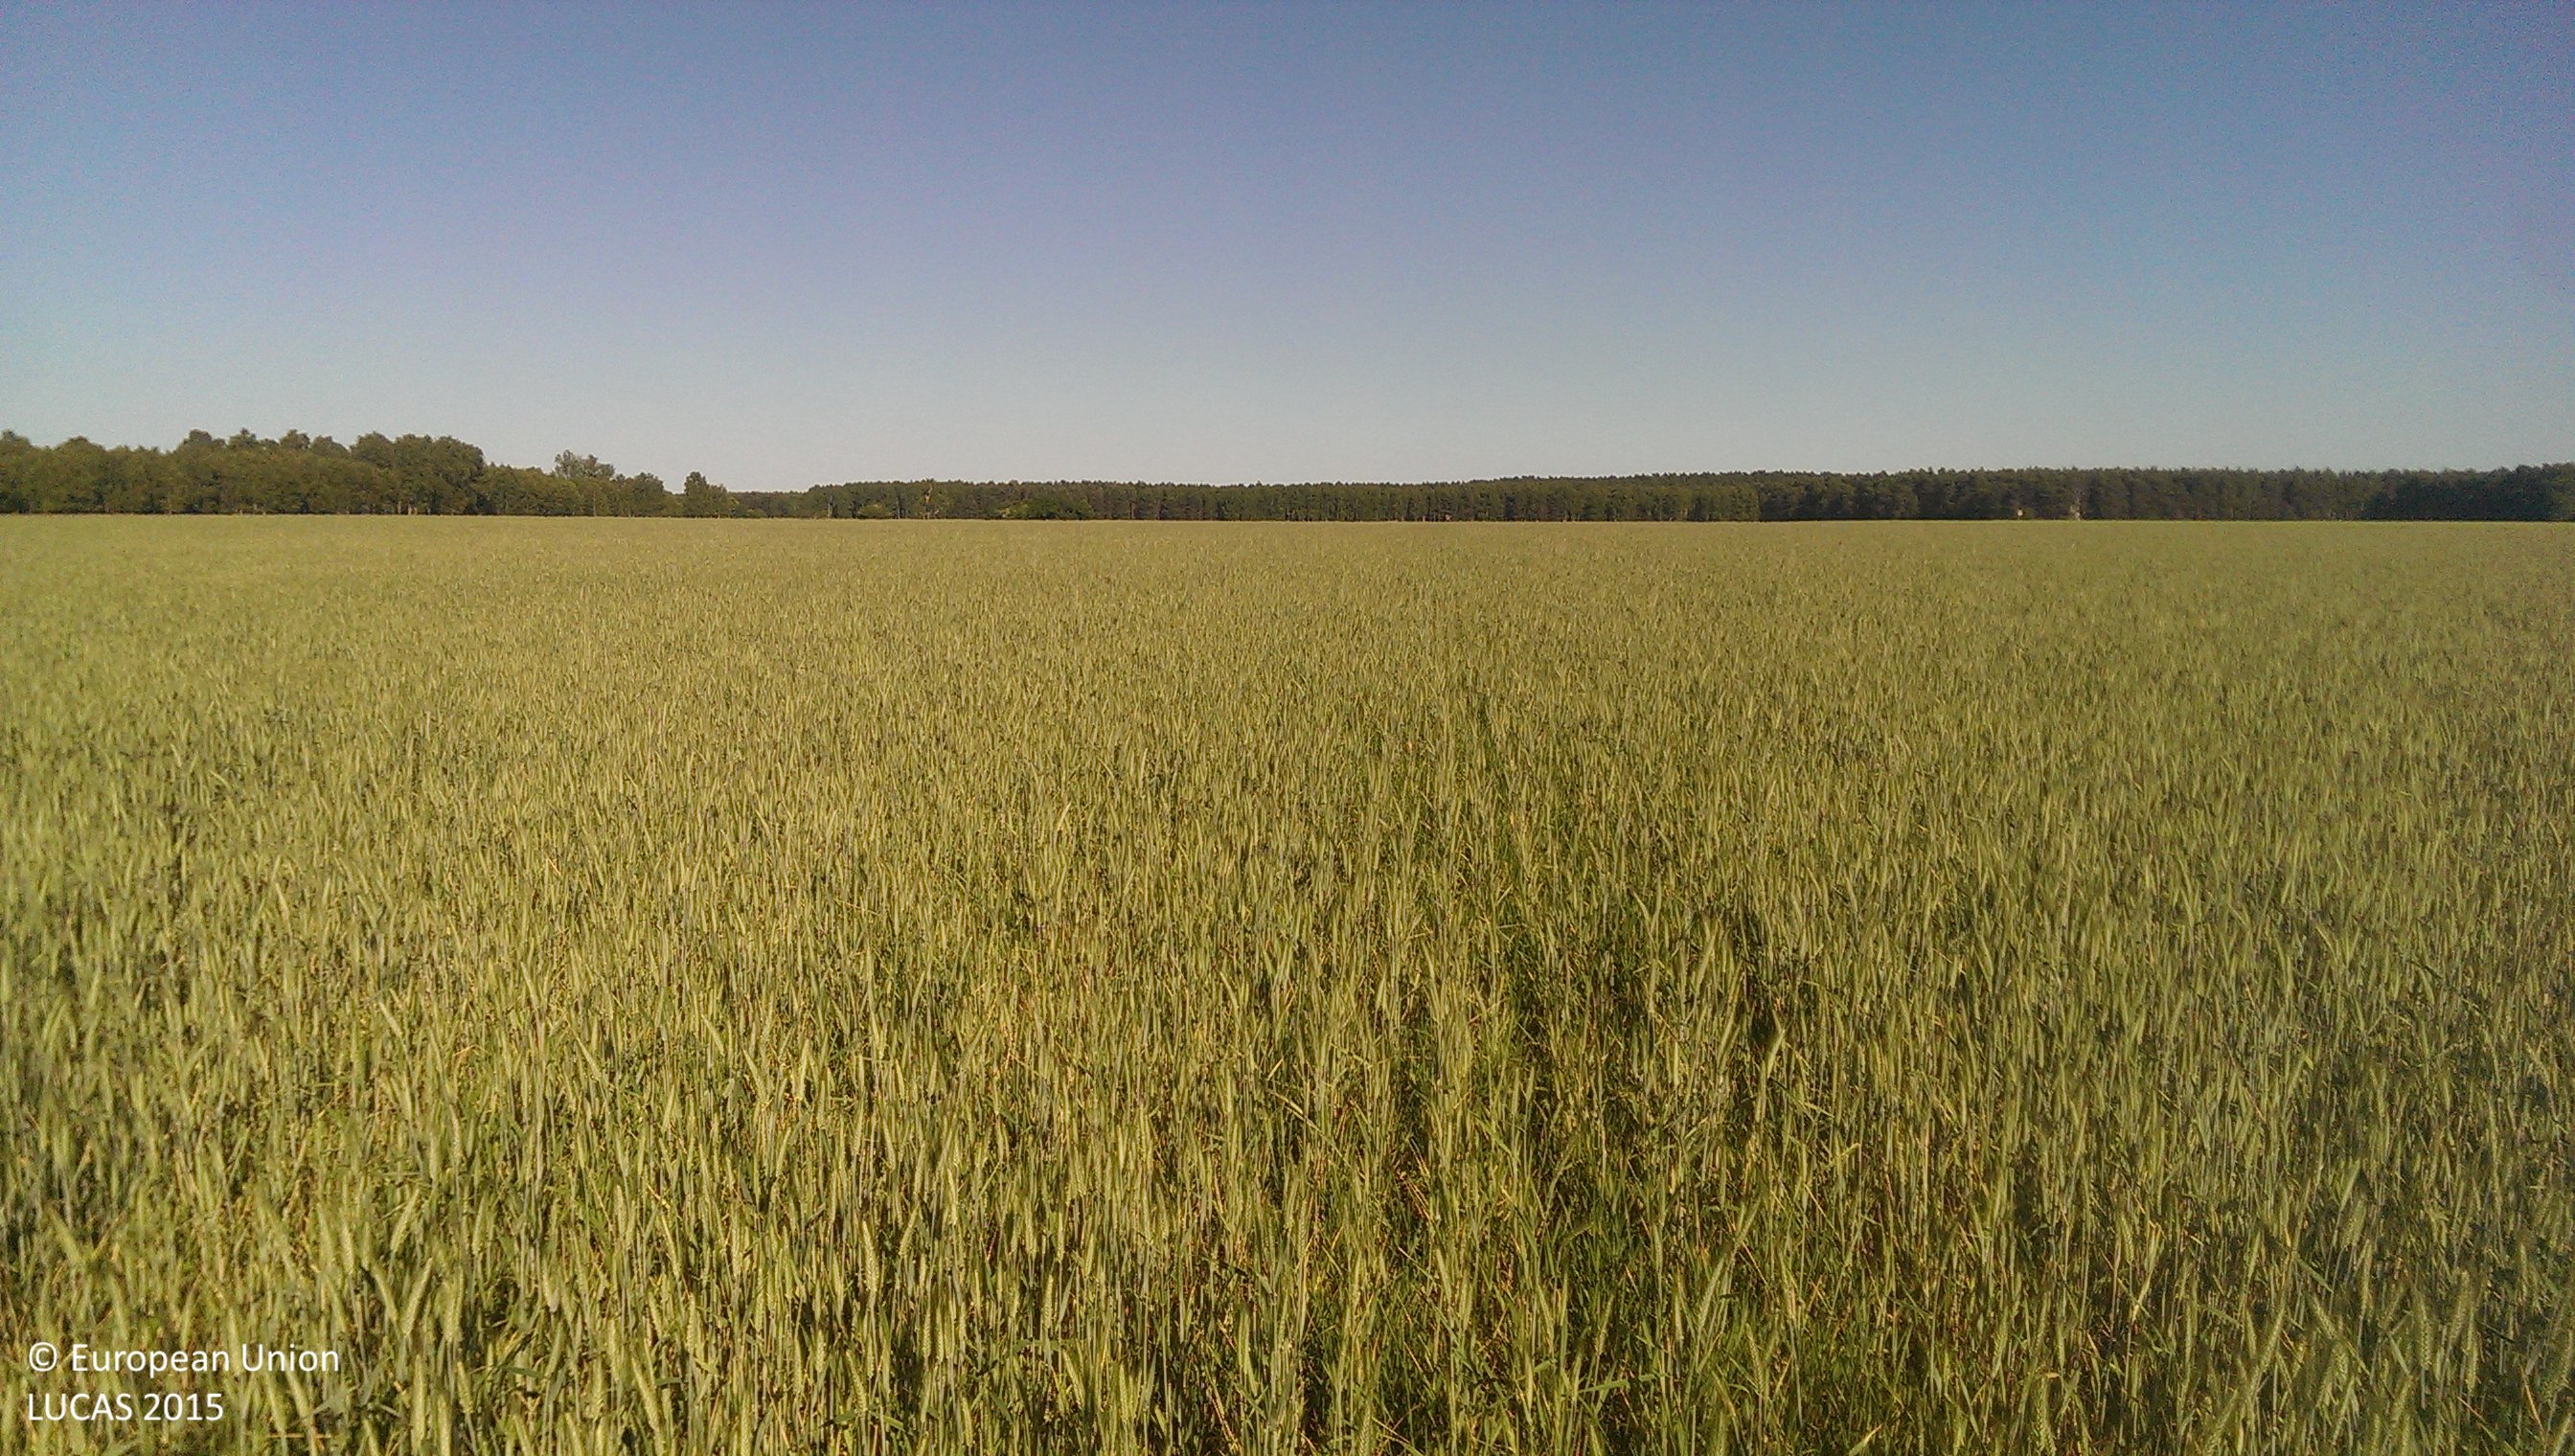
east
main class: Cropland
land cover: Triticale
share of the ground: > 75 %
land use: Agriculture (excluding fallow land and kitchen gardens)
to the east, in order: Triticale
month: June
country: PL
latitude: 51.8039
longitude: 16.1408
